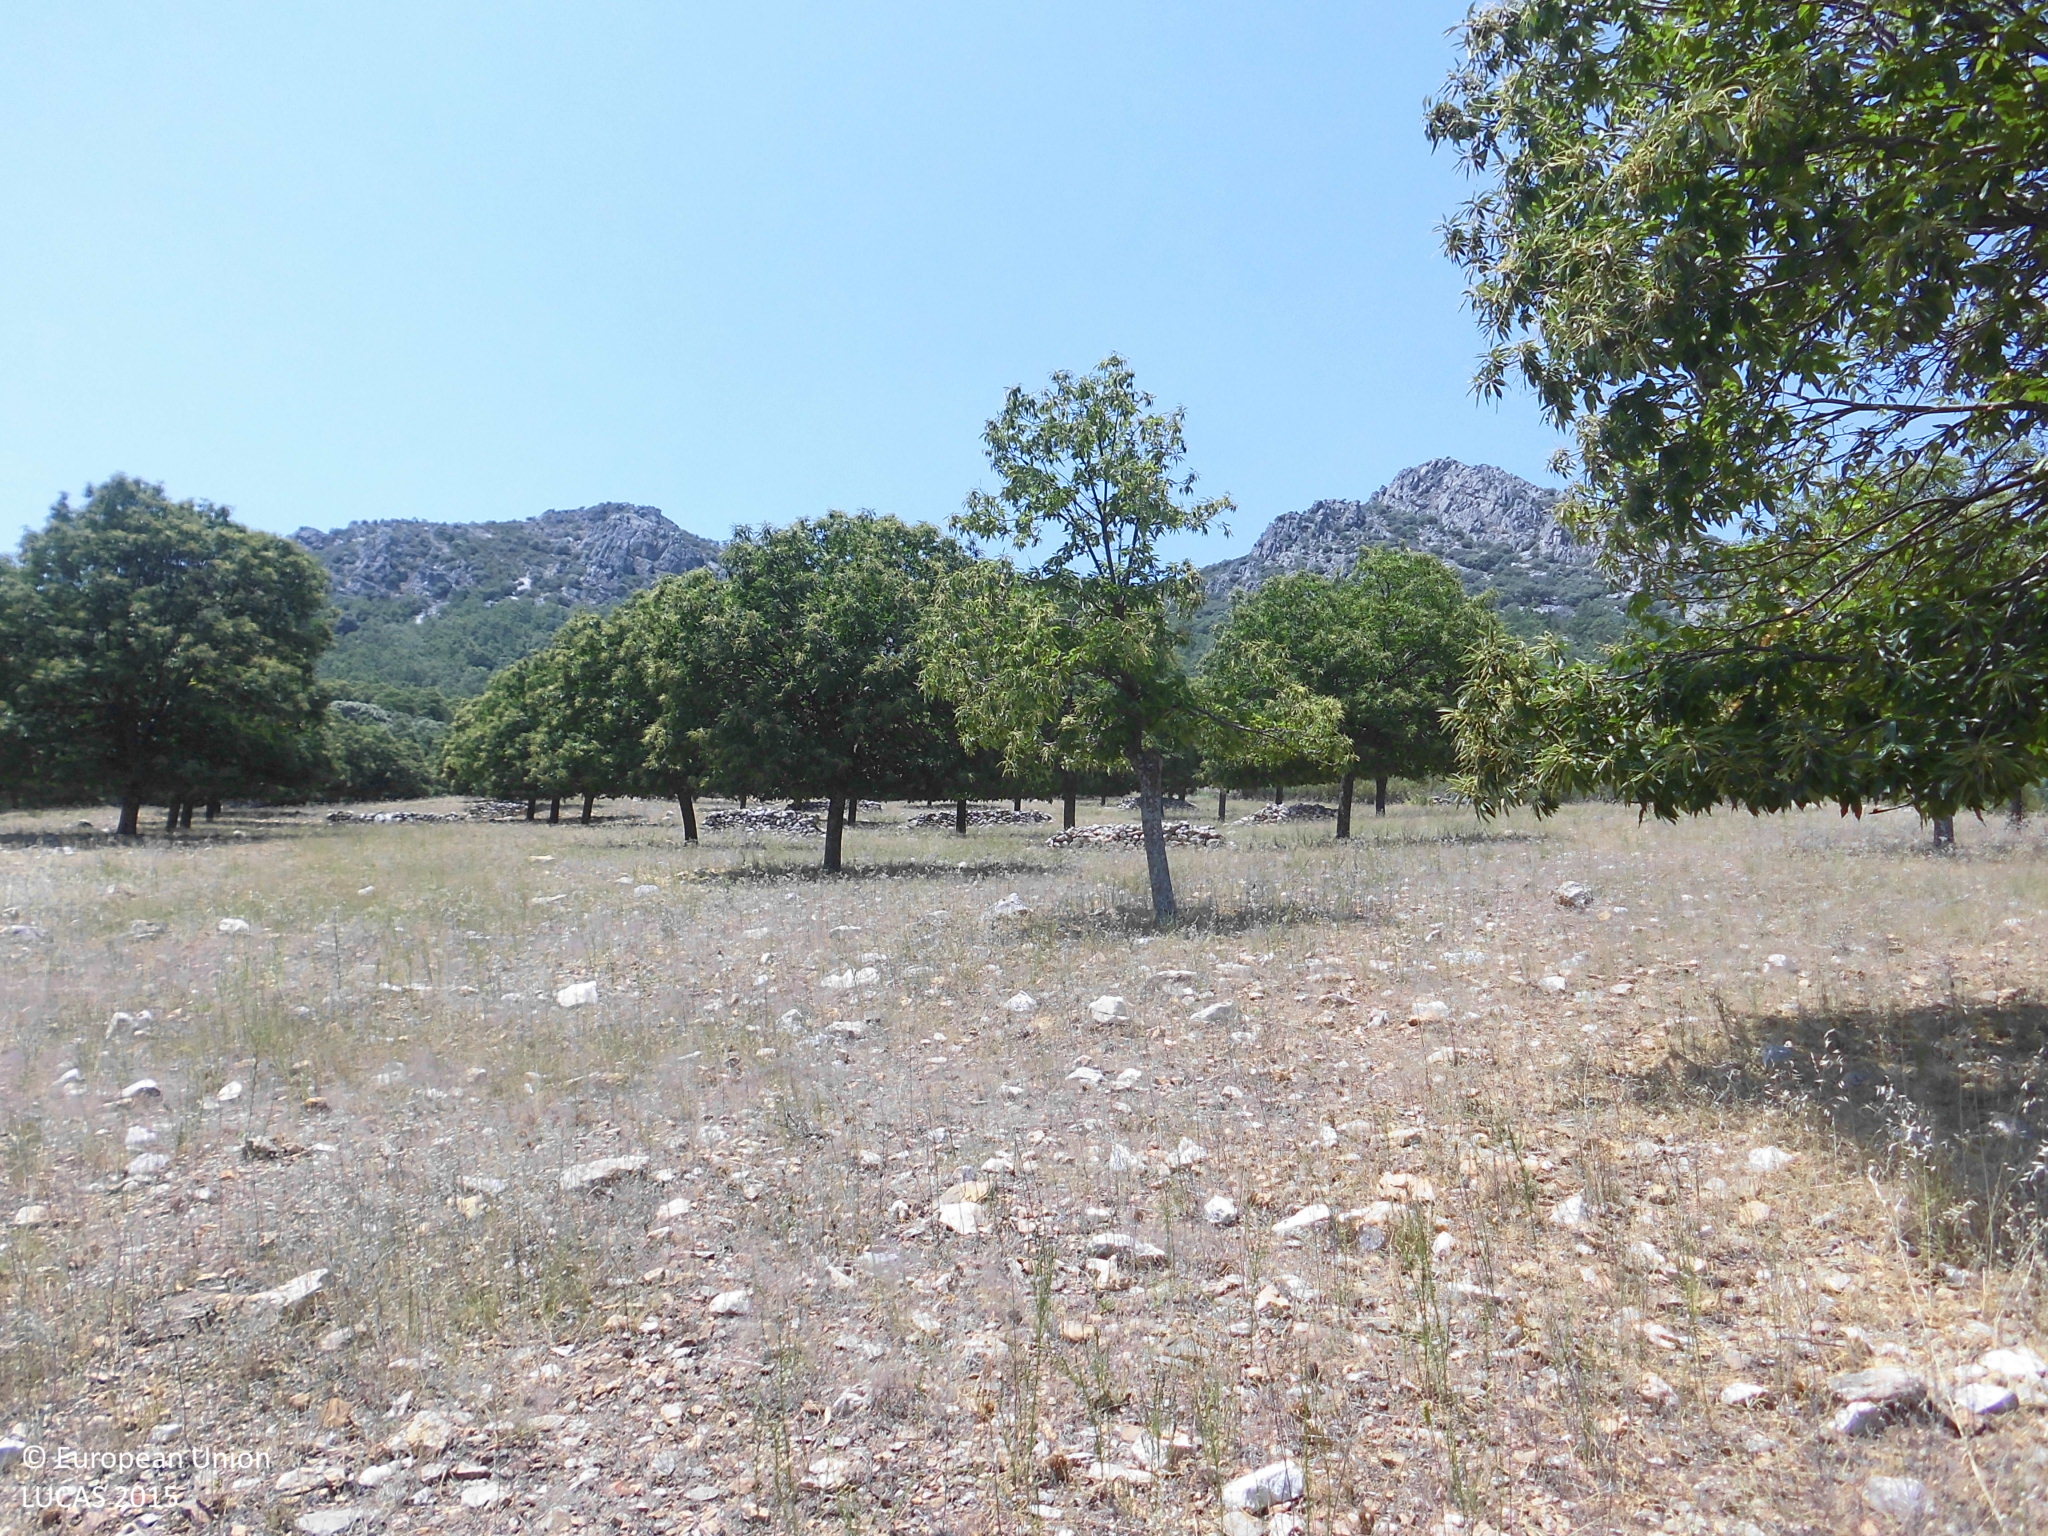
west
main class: Cropland
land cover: Nuts trees
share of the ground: 10 - 25 %
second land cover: Grassland without tree/shrub cover
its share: 50 - 75 %
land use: Agriculture (excluding fallow land and kitchen gardens)
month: June
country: ES
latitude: 39.5399
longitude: -5.3981
